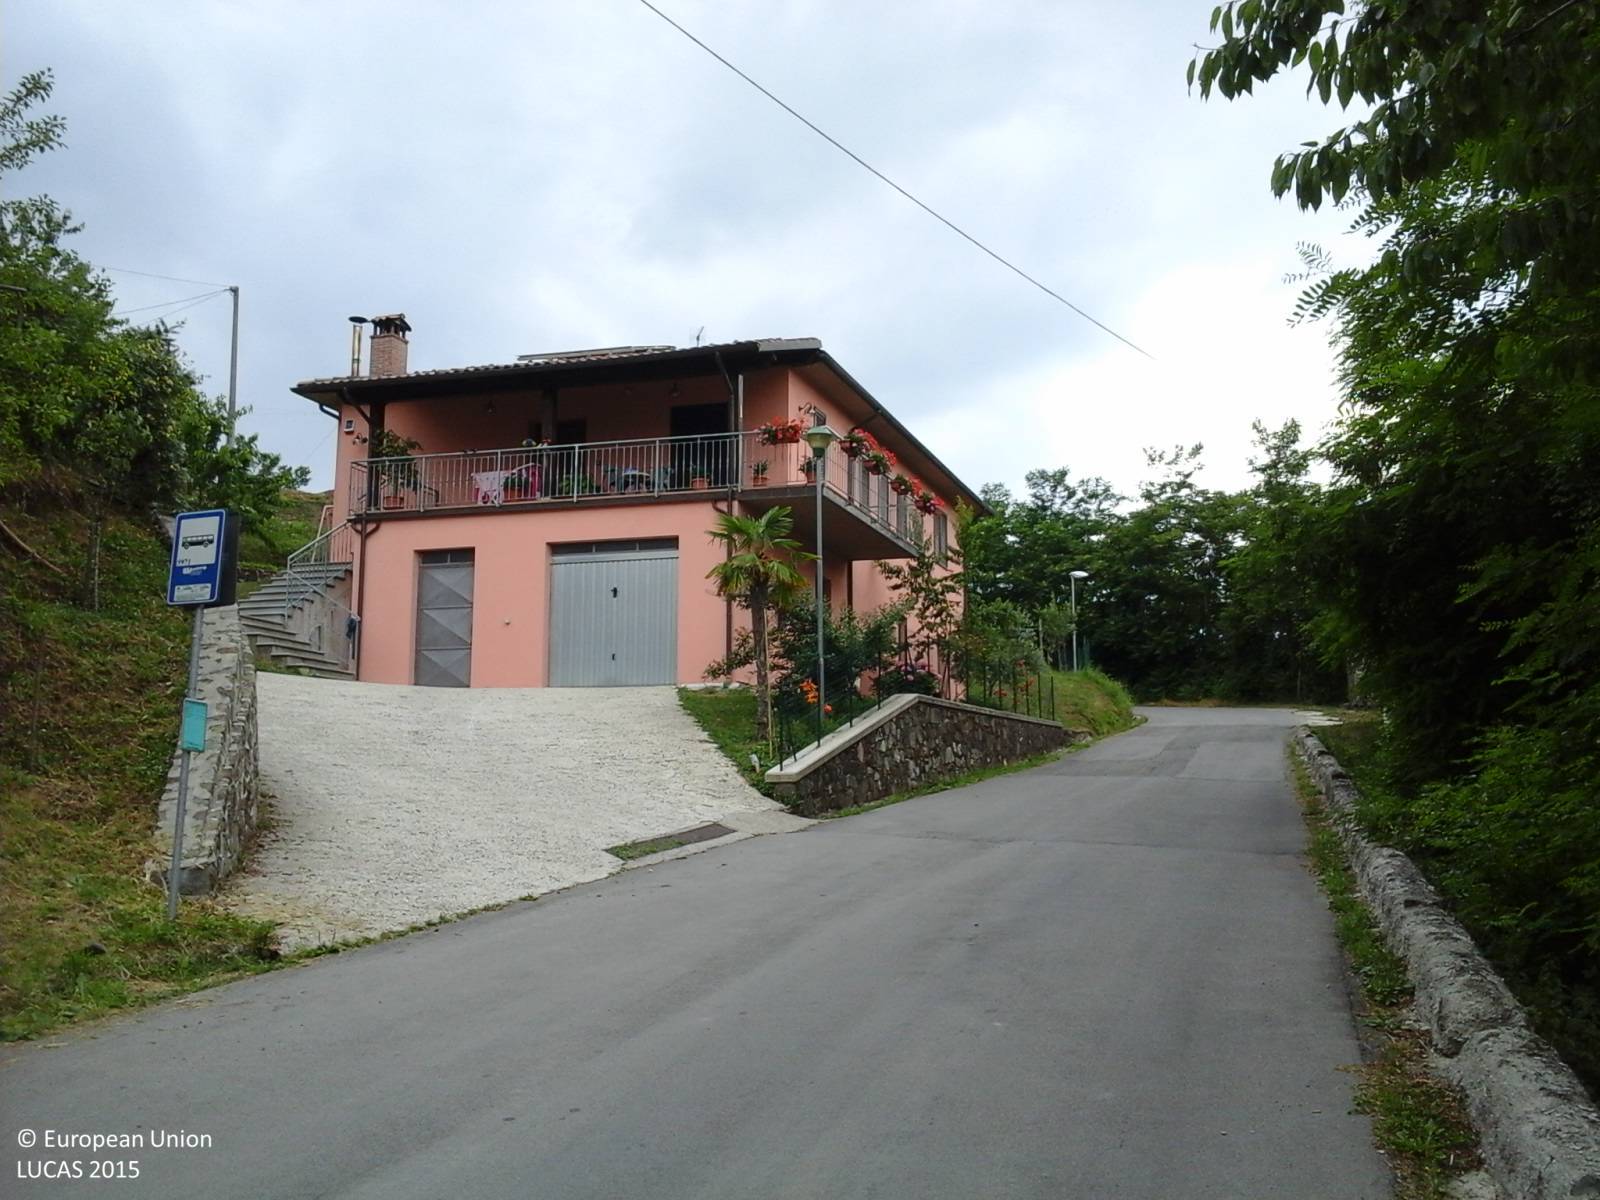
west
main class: Woodland
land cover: Broadleaved woodland
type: thermophilous deciduous forest
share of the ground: > 75 %
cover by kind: broadleaved forest trees 100 %
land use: Semi-natural and natural areas not in use
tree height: > 5 m
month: June
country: IT
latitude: 44.1697
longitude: 10.3119
